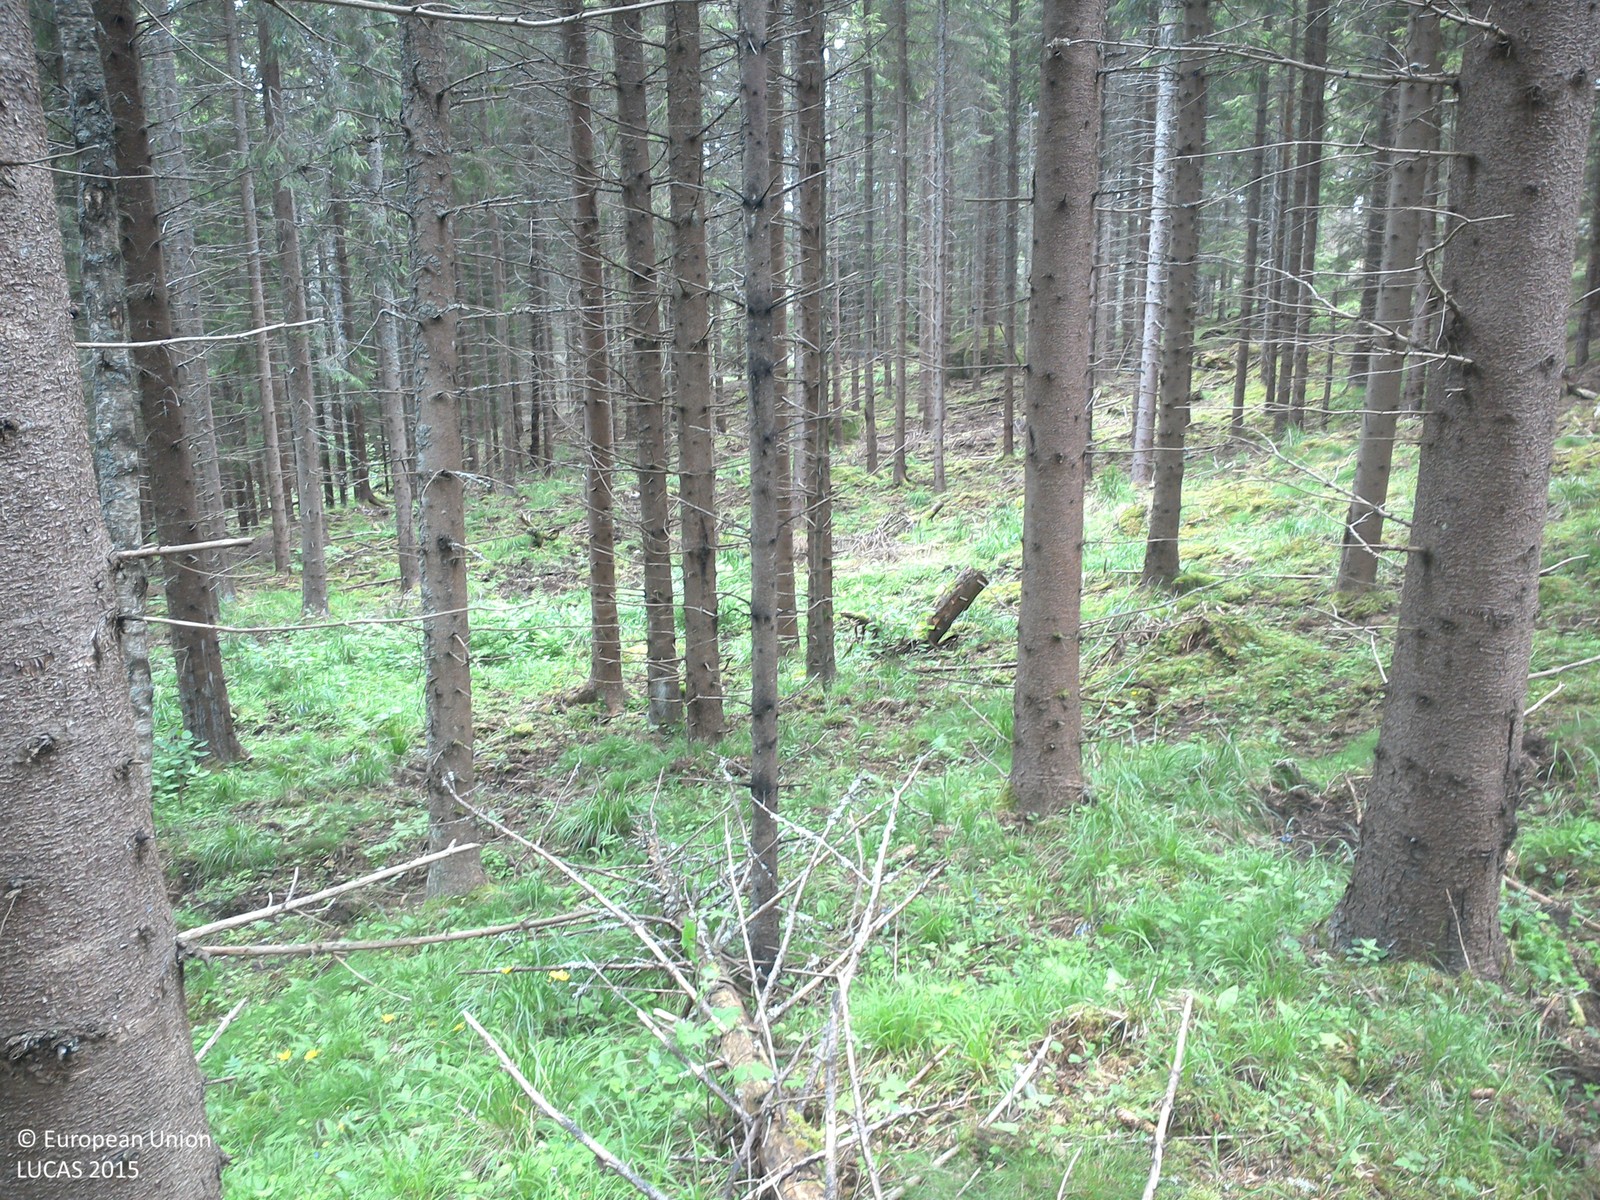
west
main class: Woodland
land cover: Spruce dominated coniferous woodland
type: boreal forest
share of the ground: 50 - 75 %
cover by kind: coniferous forest trees 60 %, lichens and mosses 40 %
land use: Forestry
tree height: > 5 m
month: June
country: SE
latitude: 58.0914
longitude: 15.4402
